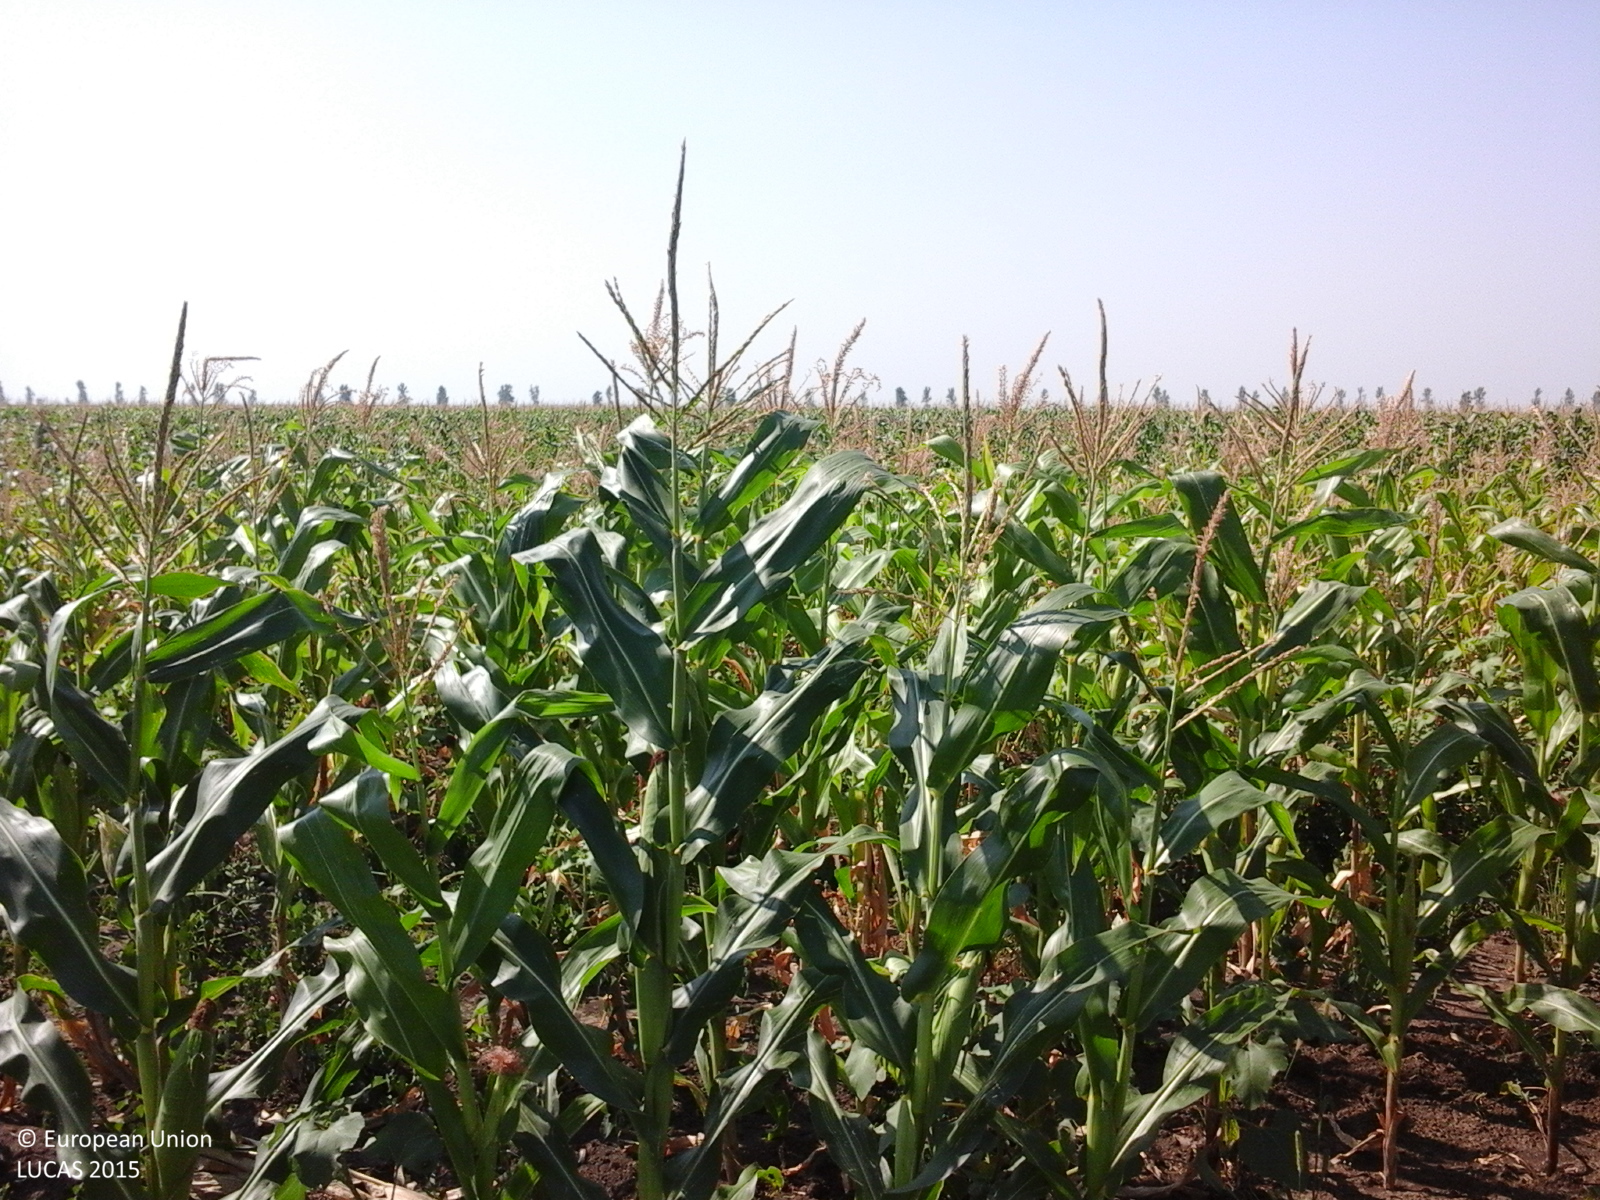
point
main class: Cropland
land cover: Maize
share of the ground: > 75 %
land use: Agriculture (excluding fallow land and kitchen gardens)
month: August
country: RO
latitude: 45.8430
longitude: 27.6603
